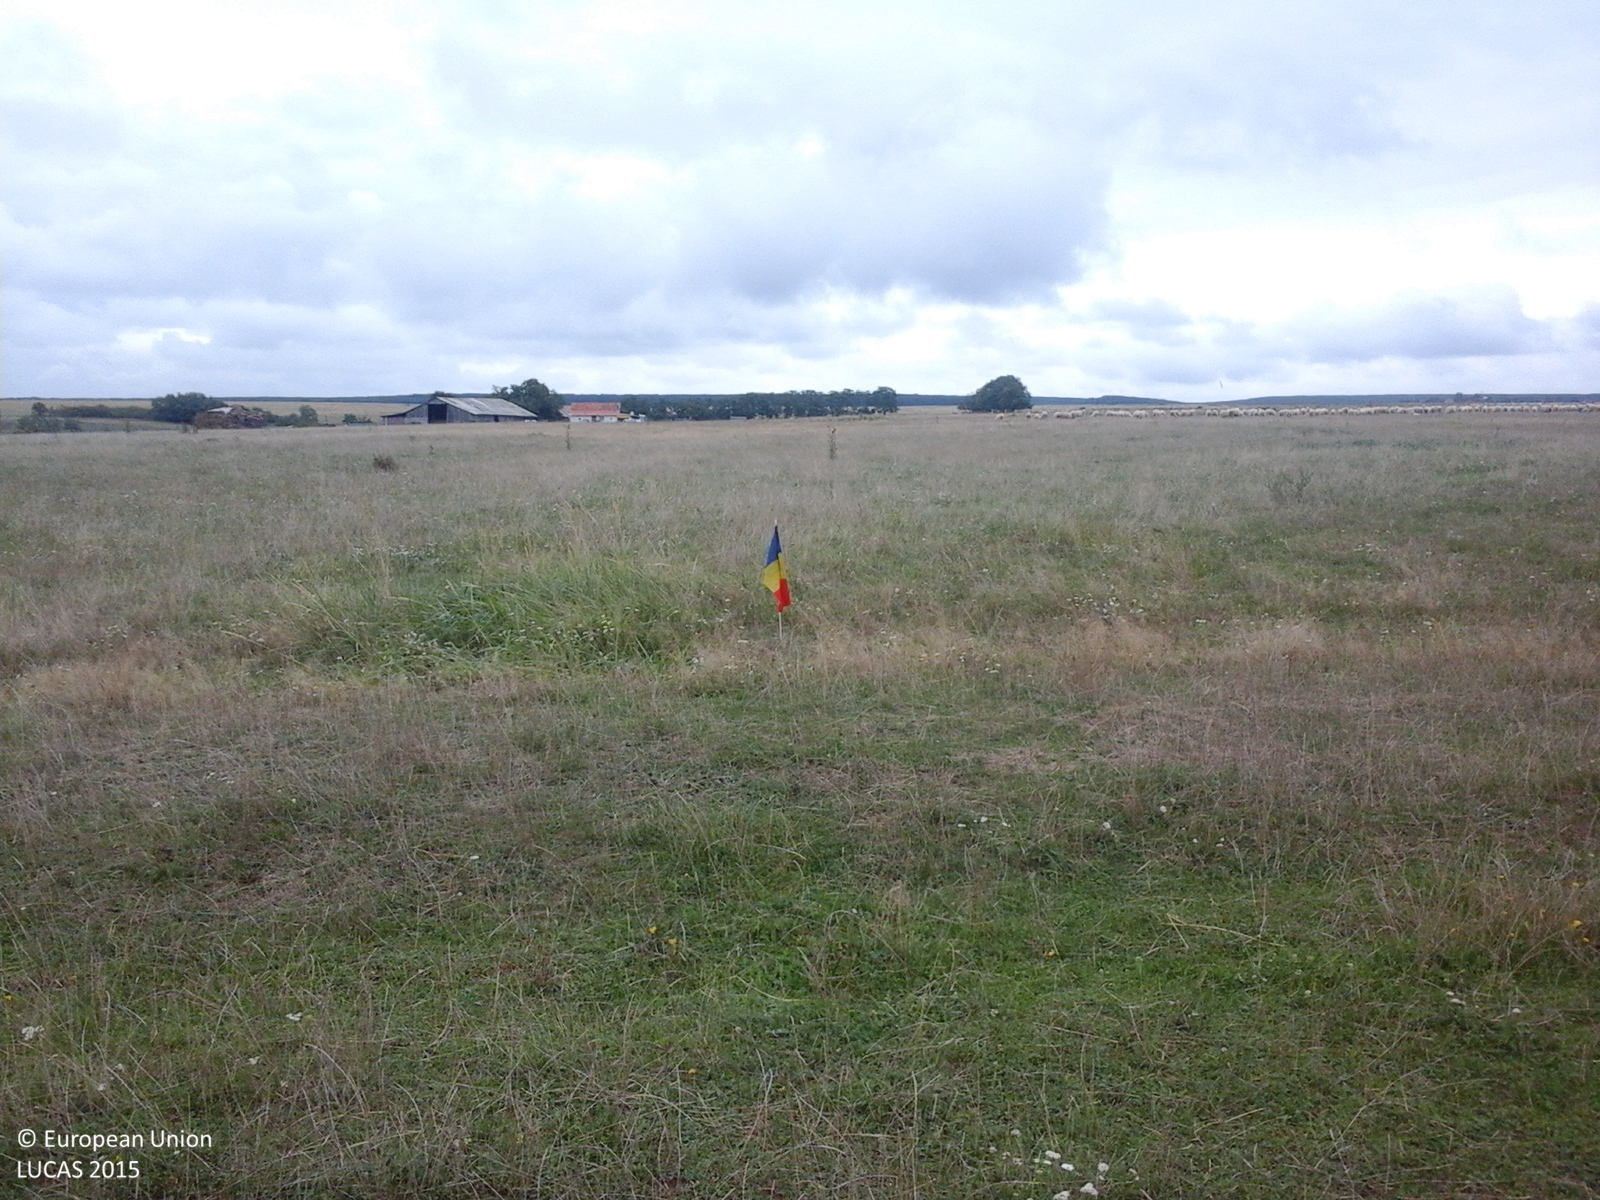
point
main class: Grassland
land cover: Grassland without tree/shrub cover
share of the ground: > 75 %
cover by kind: herbaceous plants 100 %
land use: Agriculture (excluding fallow land and kitchen gardens)
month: September
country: RO
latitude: 46.9240
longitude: 21.8774
